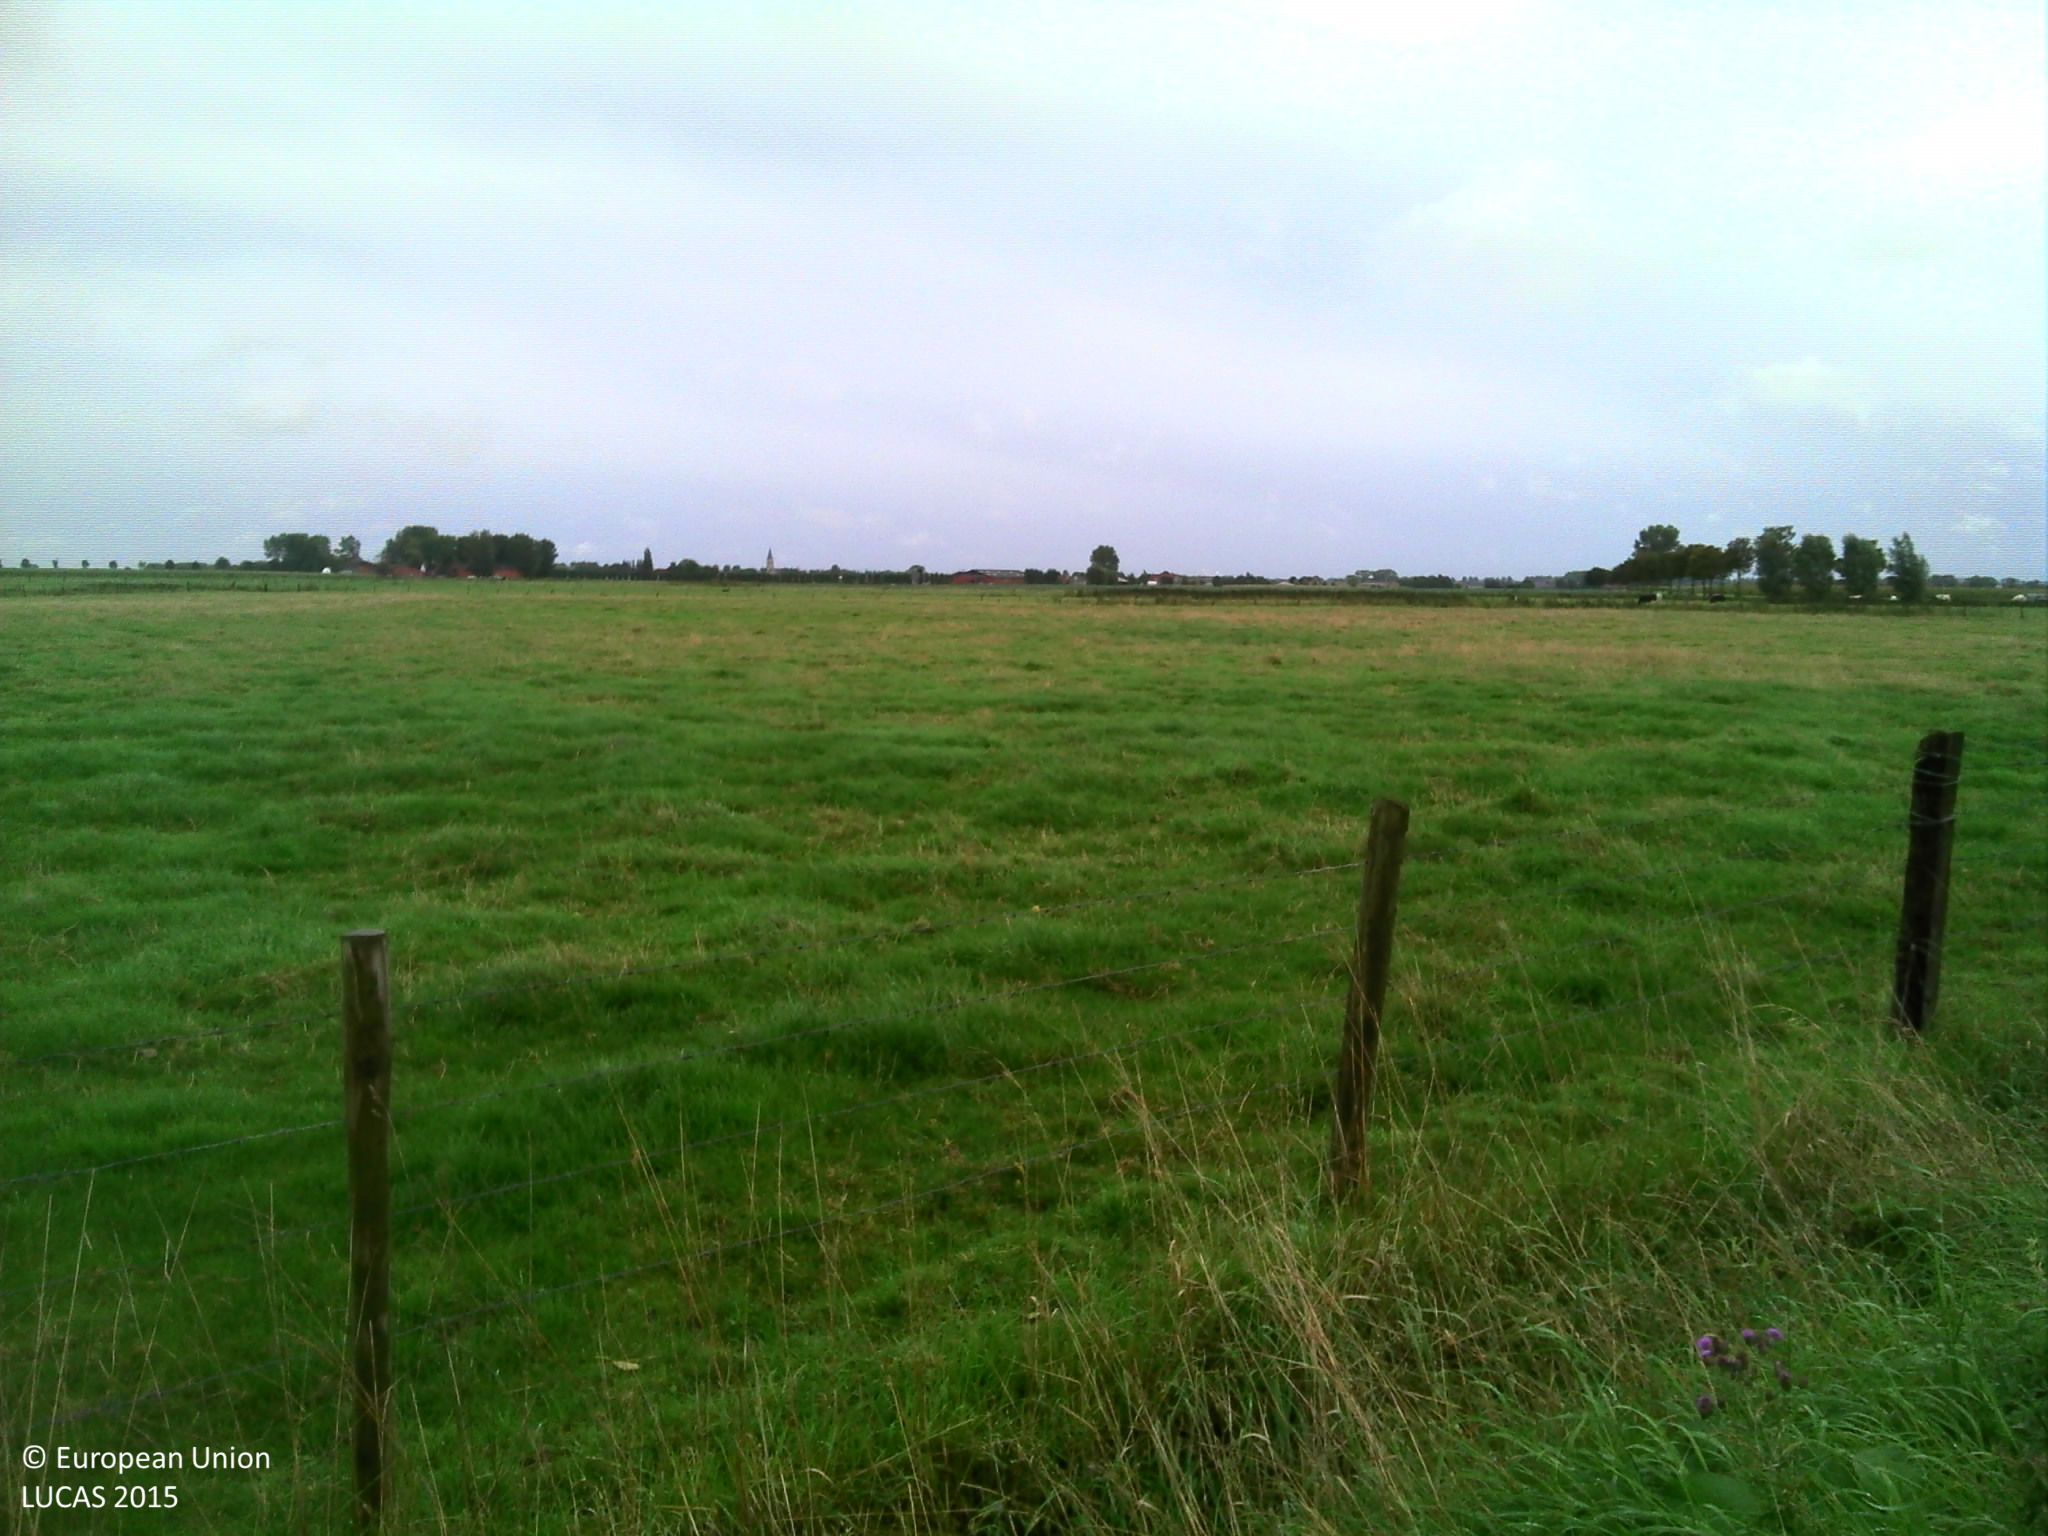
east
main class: Grassland
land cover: Grassland without tree/shrub cover
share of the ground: > 75 %
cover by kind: herbaceous plants 100 %
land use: Agriculture (excluding fallow land and kitchen gardens)
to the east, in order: Grass margins; Ditches and canals; Fences; Grassland without tree/shrub cover; Fences; Inland fresh water bodies; Fences; Grassland without tree/shrub cover
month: September
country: BE
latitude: 51.1174
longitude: 2.8892
